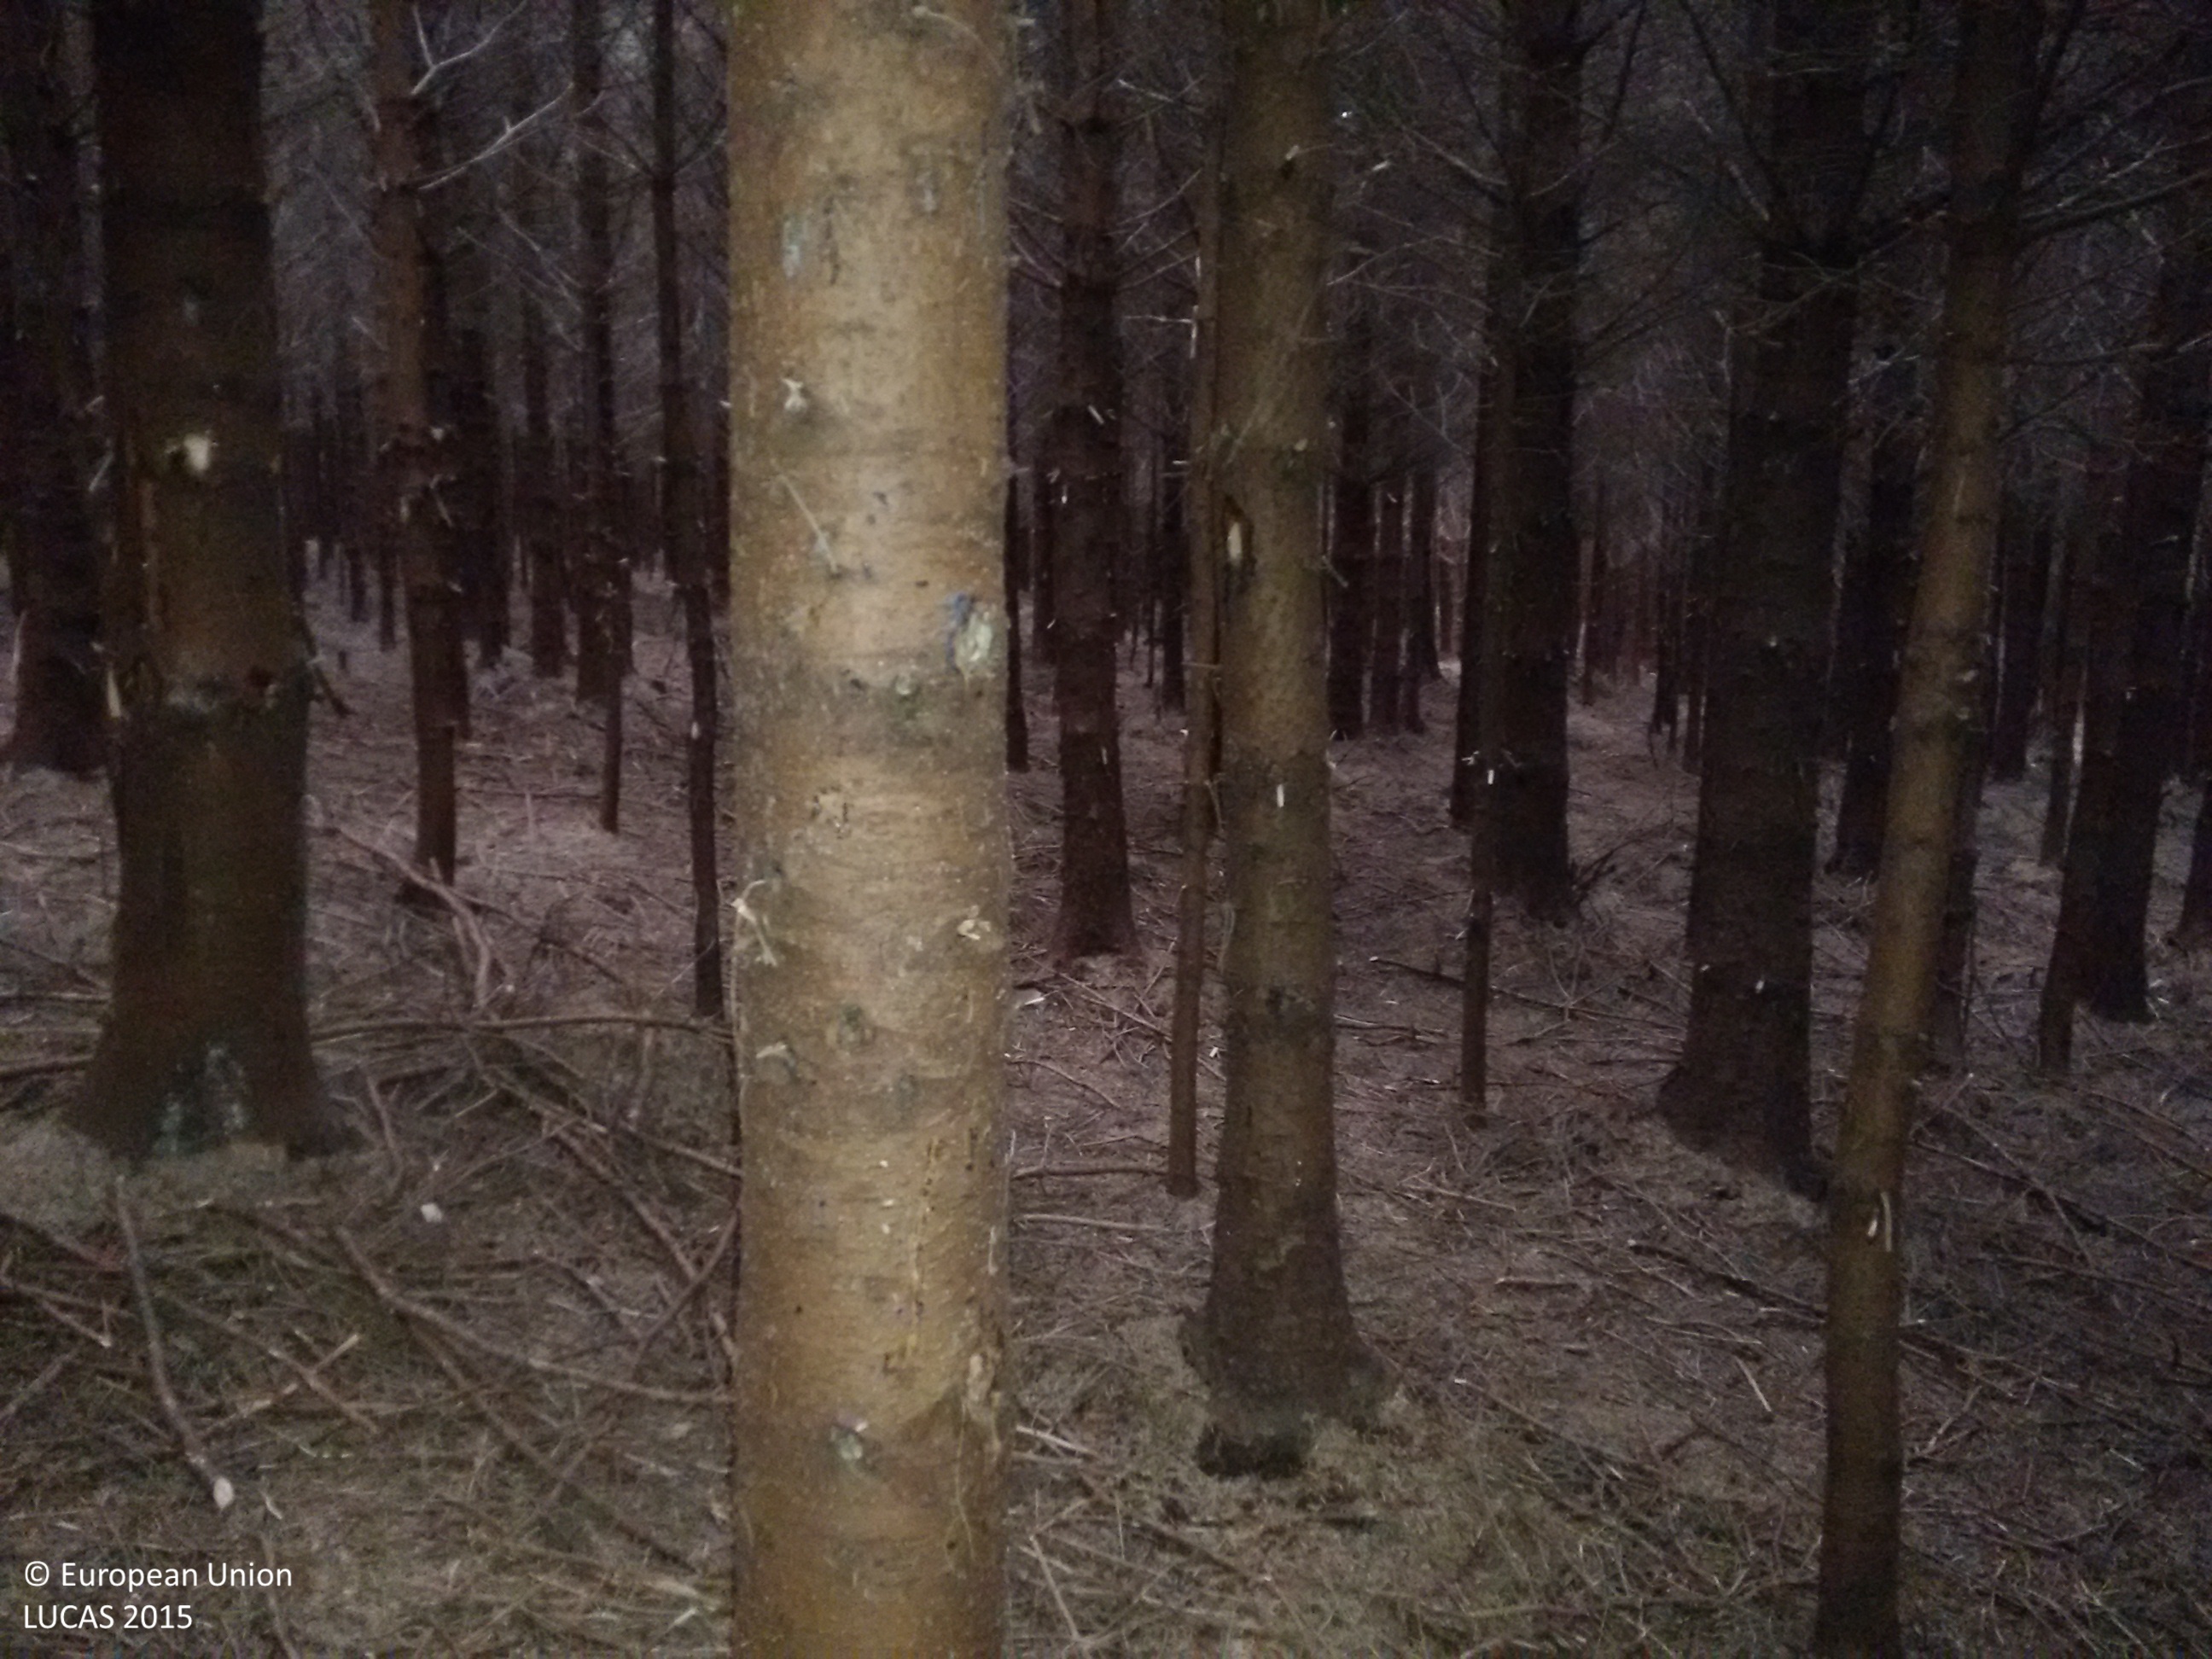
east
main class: Woodland
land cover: Spruce dominated coniferous woodland
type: exotic forest
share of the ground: > 75 %
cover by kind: coniferous forest trees 100 %
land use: Forestry
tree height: > 5 m
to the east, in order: Spruce dominated coniferous woodland; Ditches and canals; Spruce dominated coniferous woodland; Ditches and canals; Spruce dominated coniferous woodland; Ditches and canals; Spruce dominated coniferous woodland; Ditches and canals; Spruce dominated coniferous woodland; Ditches and canals; Spruce dominated coniferous woodland; Ditches and canals; Spruce dominated coniferous woodland; Ditches and canals; Spruce dominated coniferous woodland; Ditches and canals; Spruce dominated coniferous woodland; Ditches and canals; Spruce dominated coniferous woodland; Ditches and canals; Spruce dominated coniferous woodland; Ditches and canals; Spruce dominated coniferous woodland; Ditches and canals; Spruce dominated coniferous woodland; Ditches and canals; Spruce dominated coniferous woodland; Ditches and canals; Spruce dominated coniferous woodland
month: September
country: IE
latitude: 52.9969
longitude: -9.2805
